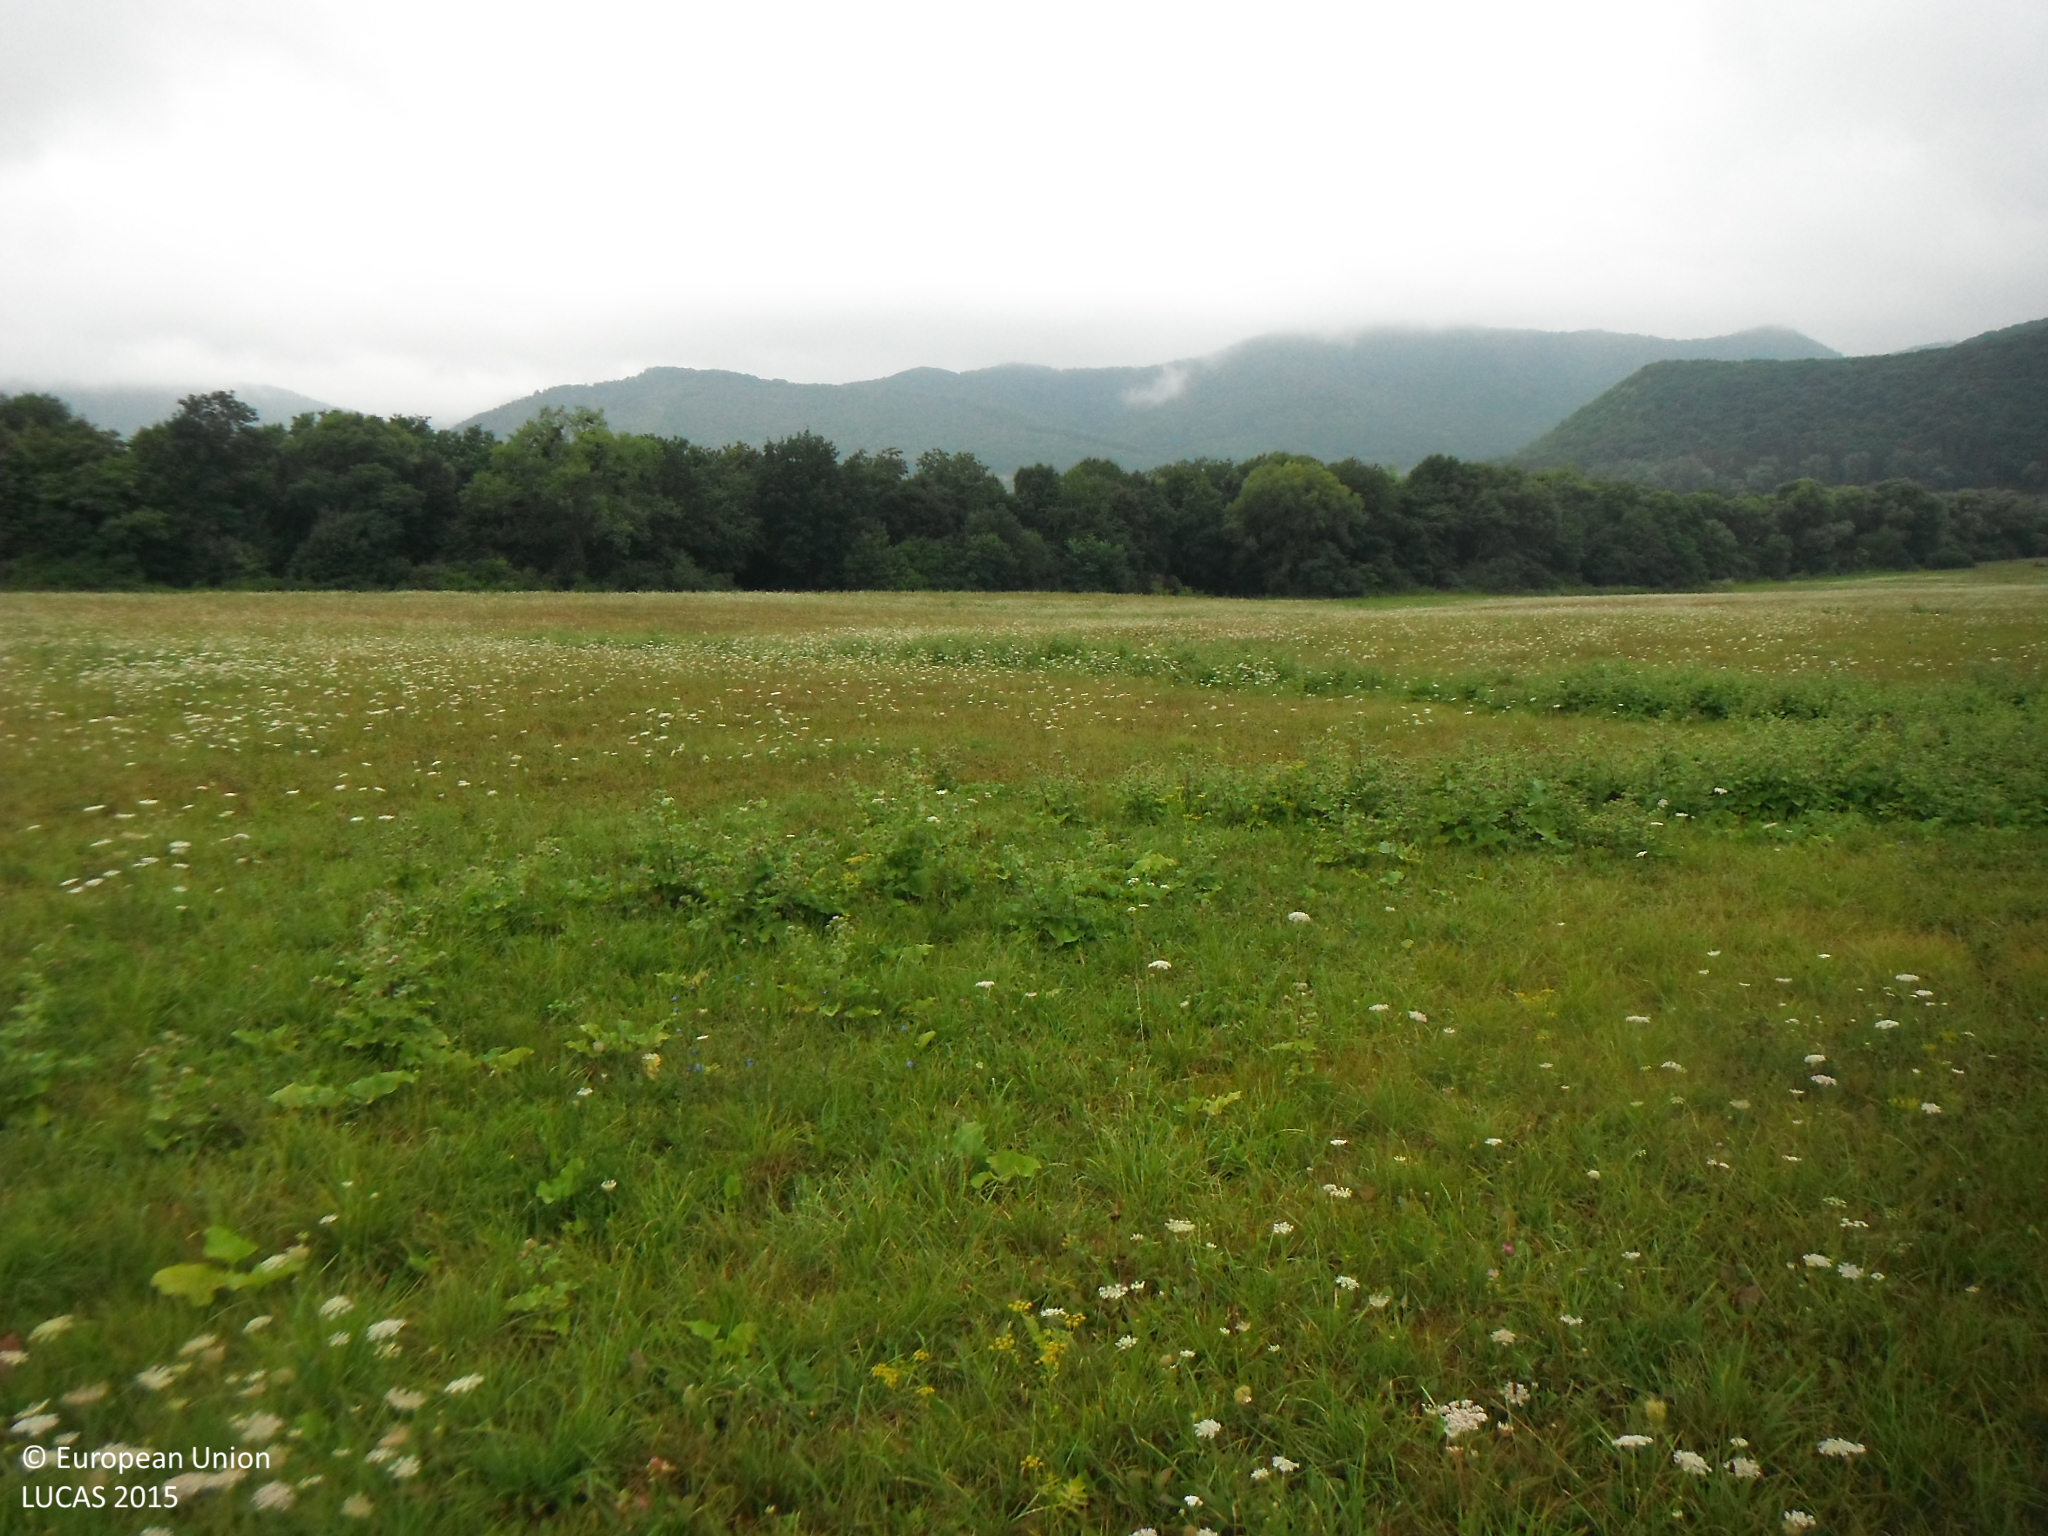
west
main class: Grassland
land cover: Grassland without tree/shrub cover
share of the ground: > 75 %
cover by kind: herbaceous plants 100 %
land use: Agriculture (excluding fallow land and kitchen gardens)
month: July
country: SK
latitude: 48.8971
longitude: 21.9630
